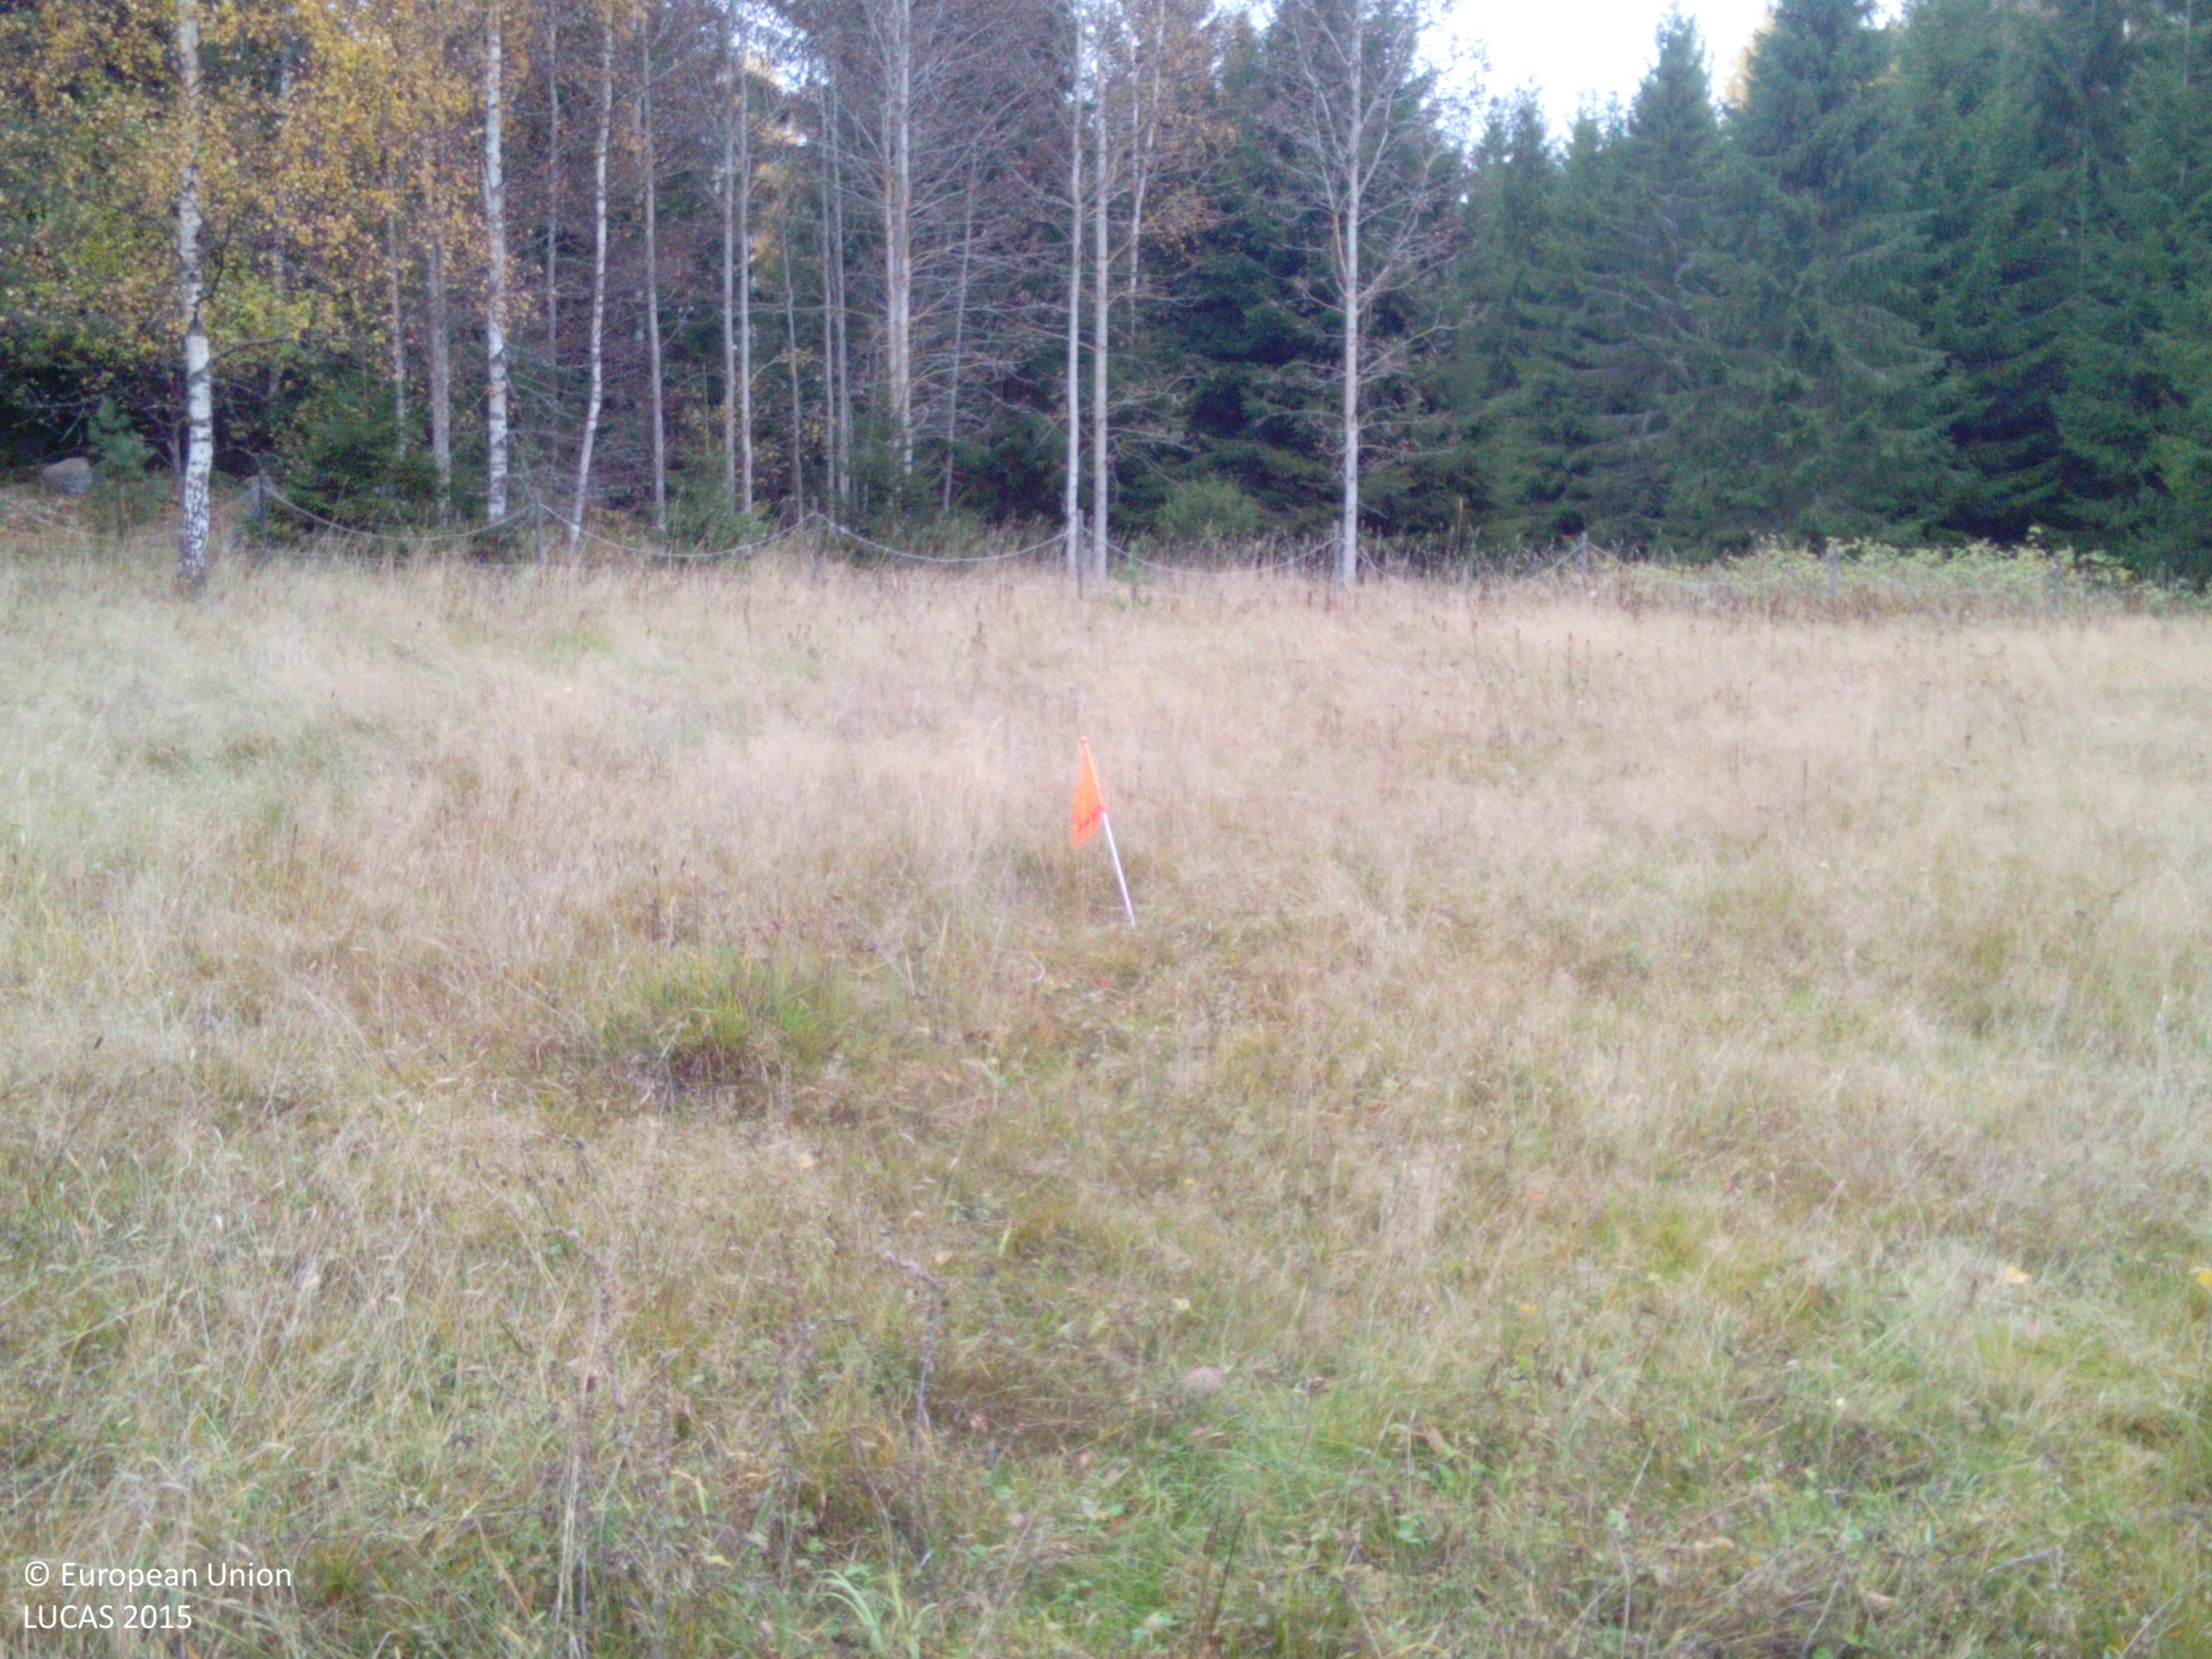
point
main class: Grassland
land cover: Grassland without tree/shrub cover
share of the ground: > 75 %
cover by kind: herbaceous plants 100 %
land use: Agriculture (excluding fallow land and kitchen gardens)
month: October
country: SE
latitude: 59.2474
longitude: 16.2524
